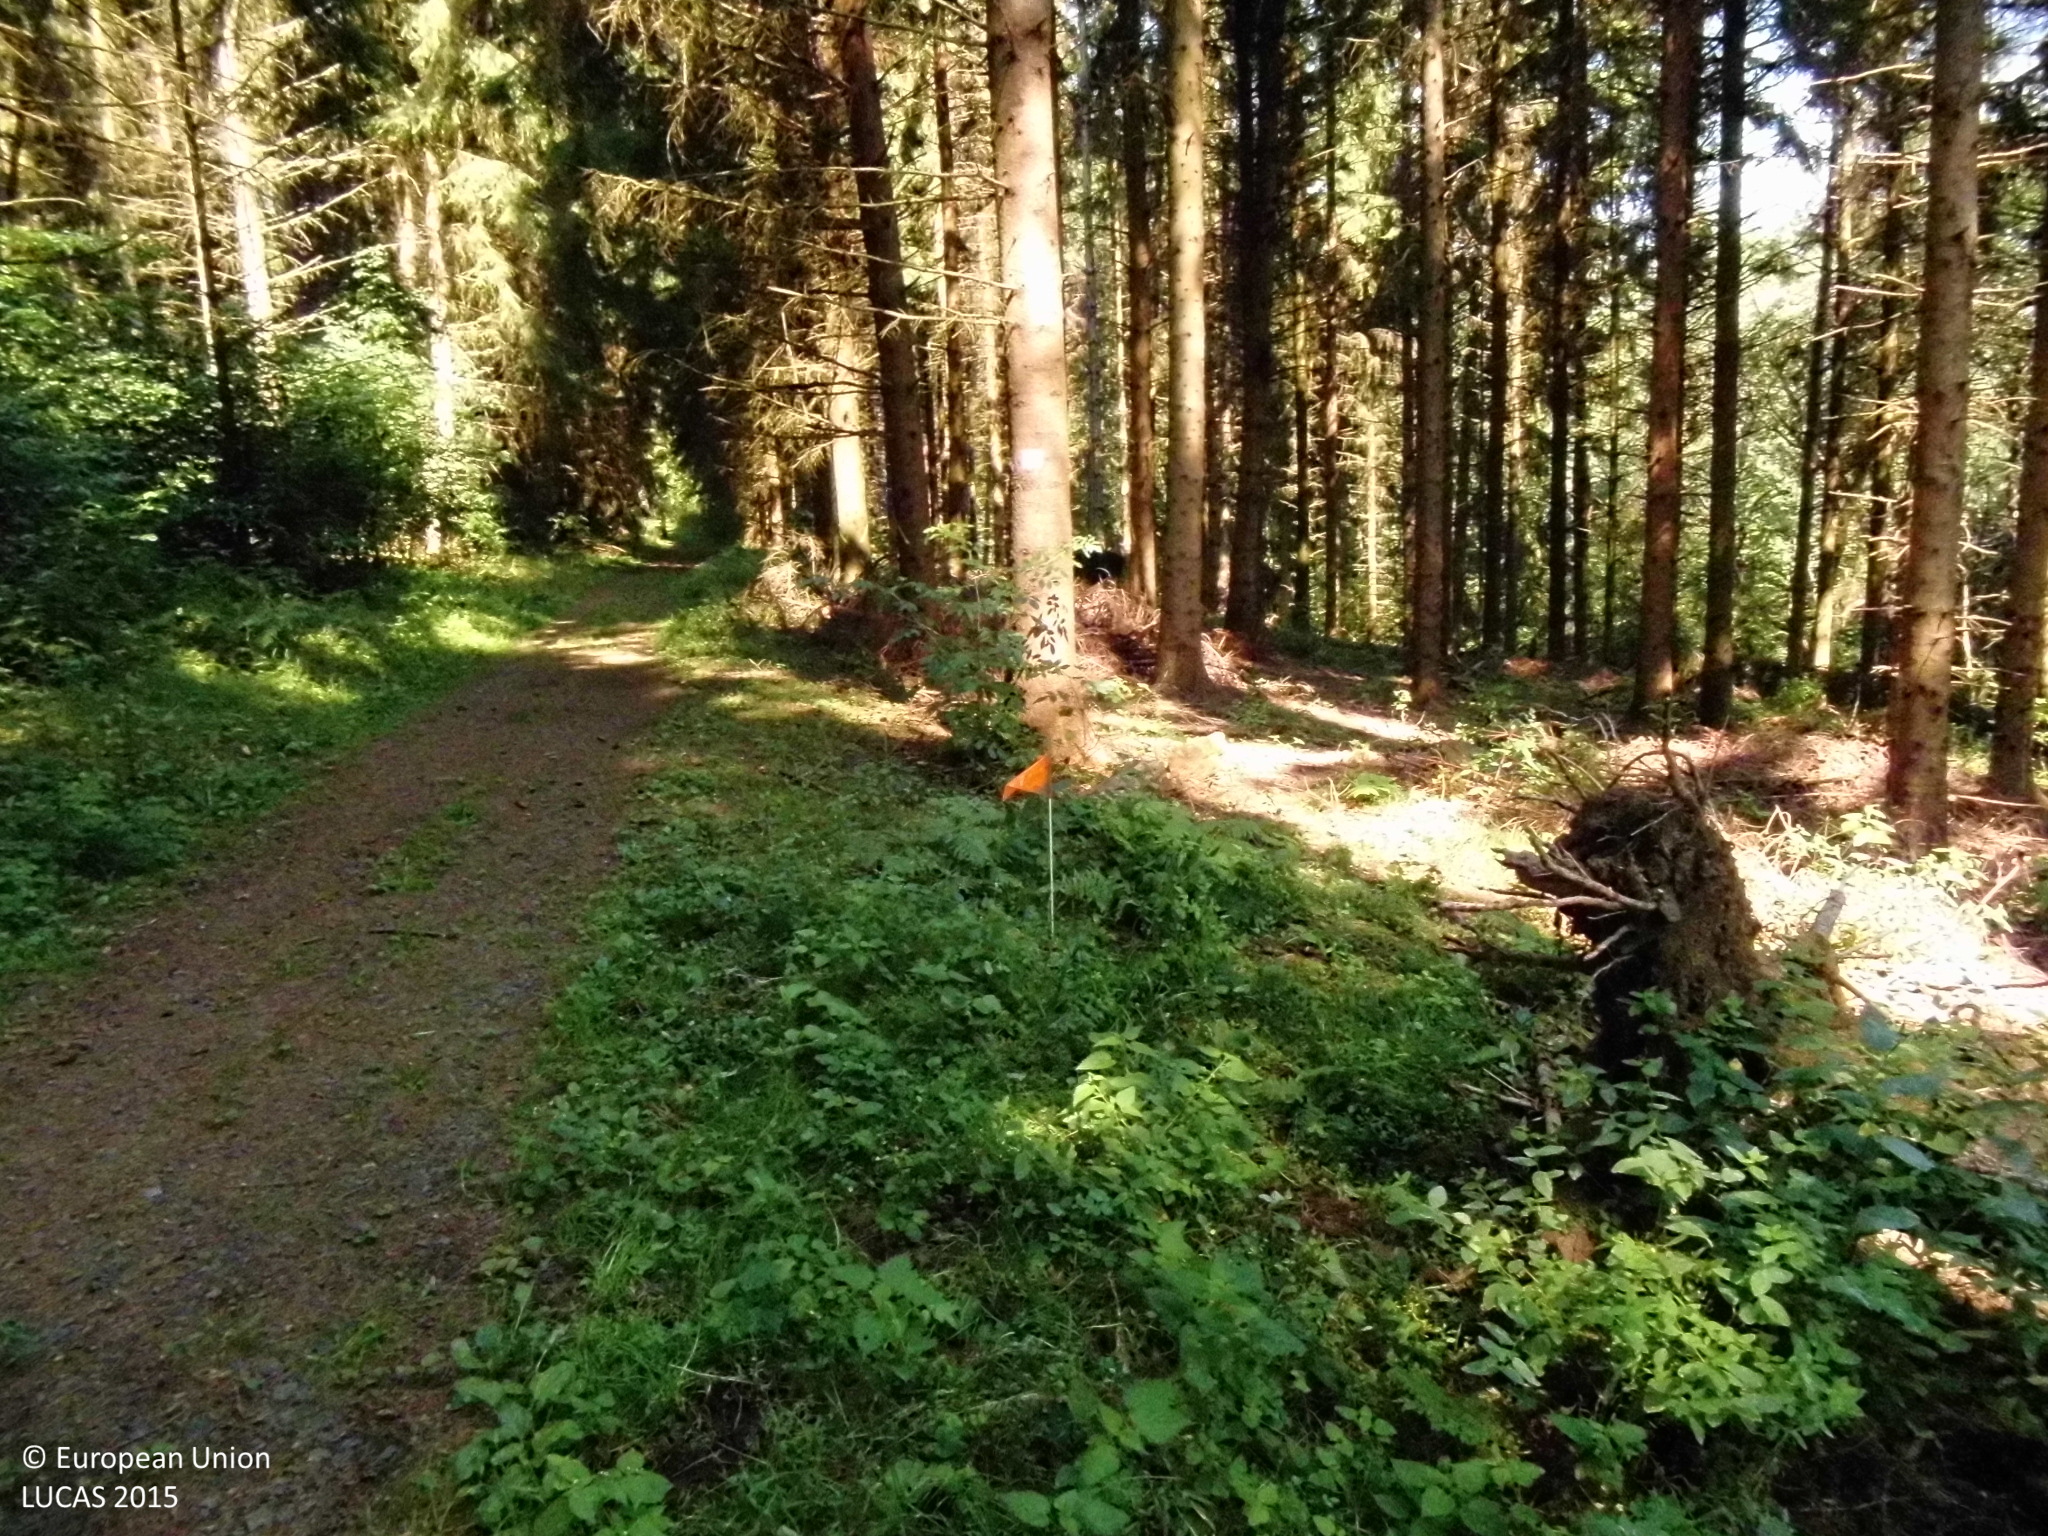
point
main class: Woodland
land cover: Spruce dominated coniferous woodland
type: hemiboreal forest and nemoral coniferous forest and mixed broadleaved-coniferous forest
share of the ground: > 75 %
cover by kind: coniferous forest trees 75 %, herbaceous plants 10 %, broadleaved forest trees 5 %, shrubs 5 %, unconsolidated bare surface 5 %
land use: Forestry
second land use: Amenities, museums, leisure
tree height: > 5 m
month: August
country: DE
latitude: 50.5626
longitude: 8.0099
